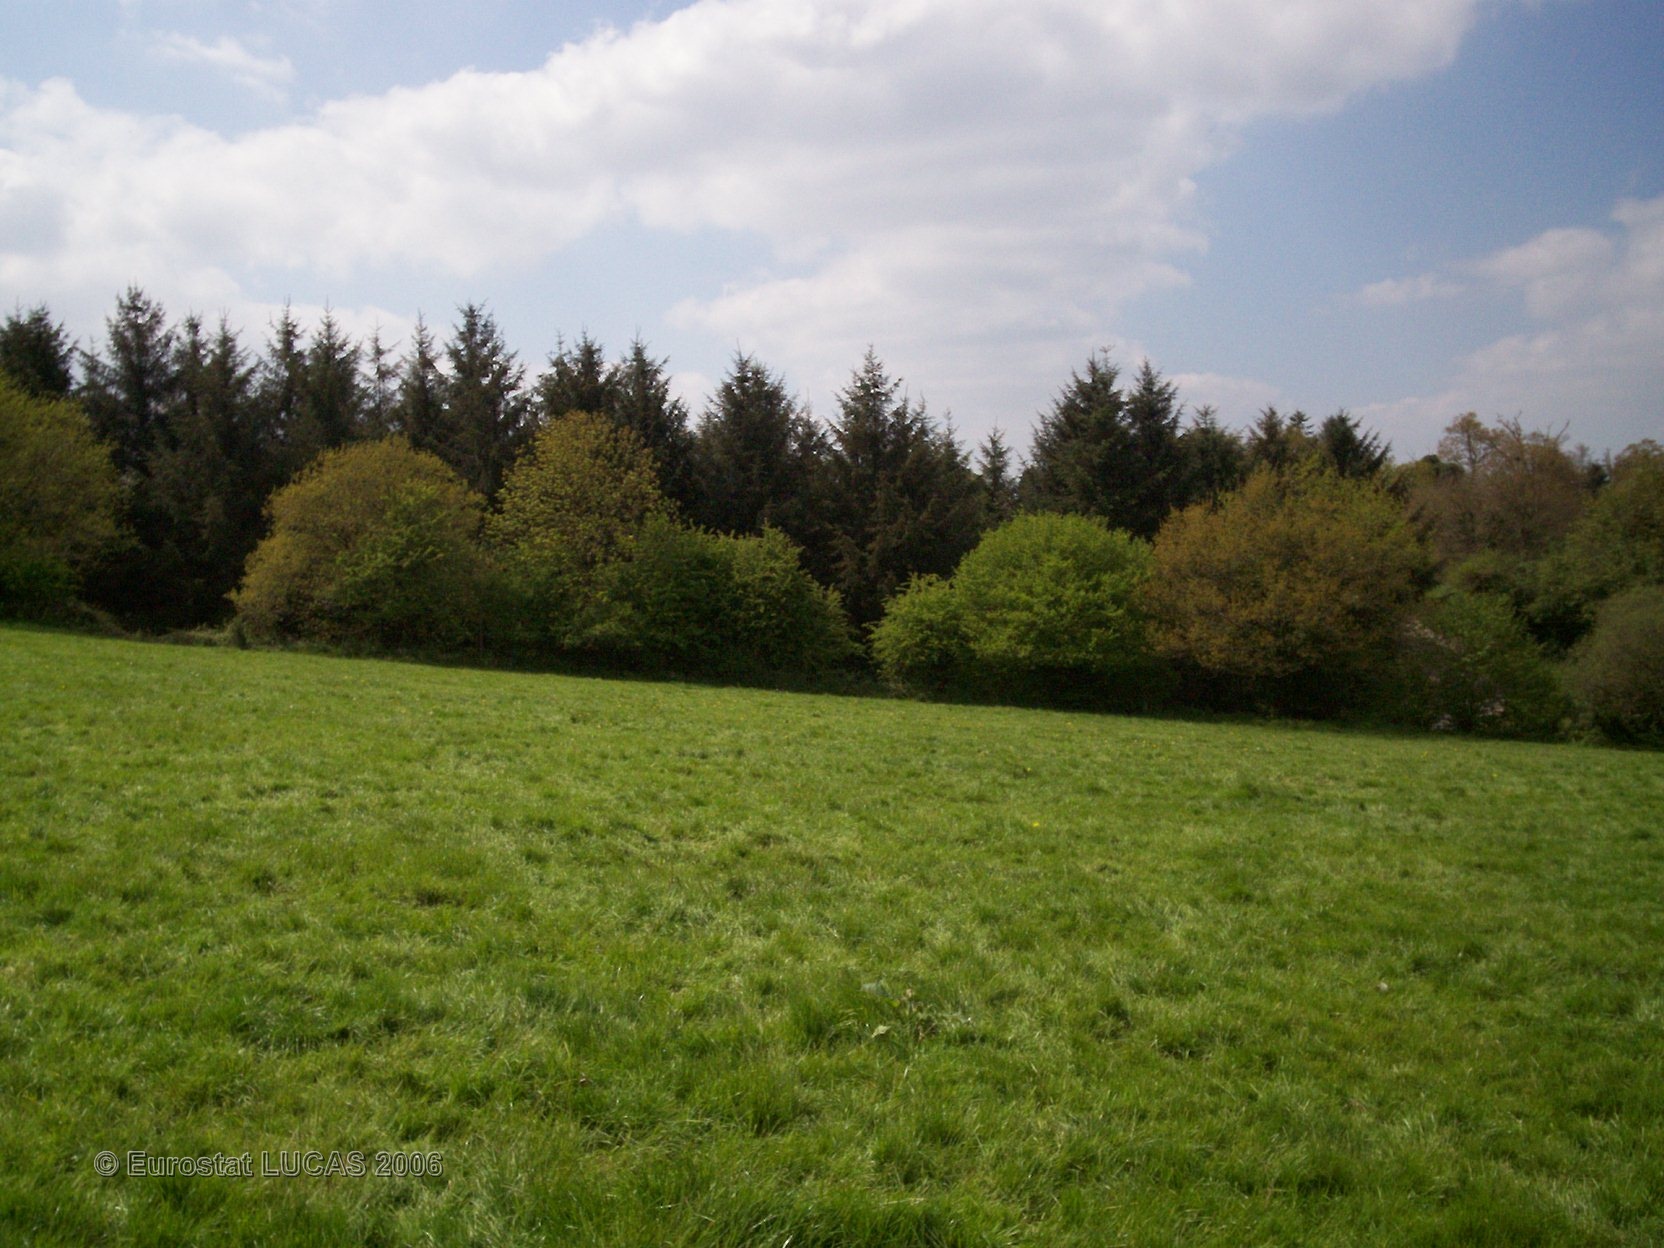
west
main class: Grassland
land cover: Grassland without tree/shrub cover
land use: Agriculture (excluding fallow land and kitchen gardens)
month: May
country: FR
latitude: 48.3523
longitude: -3.6706
